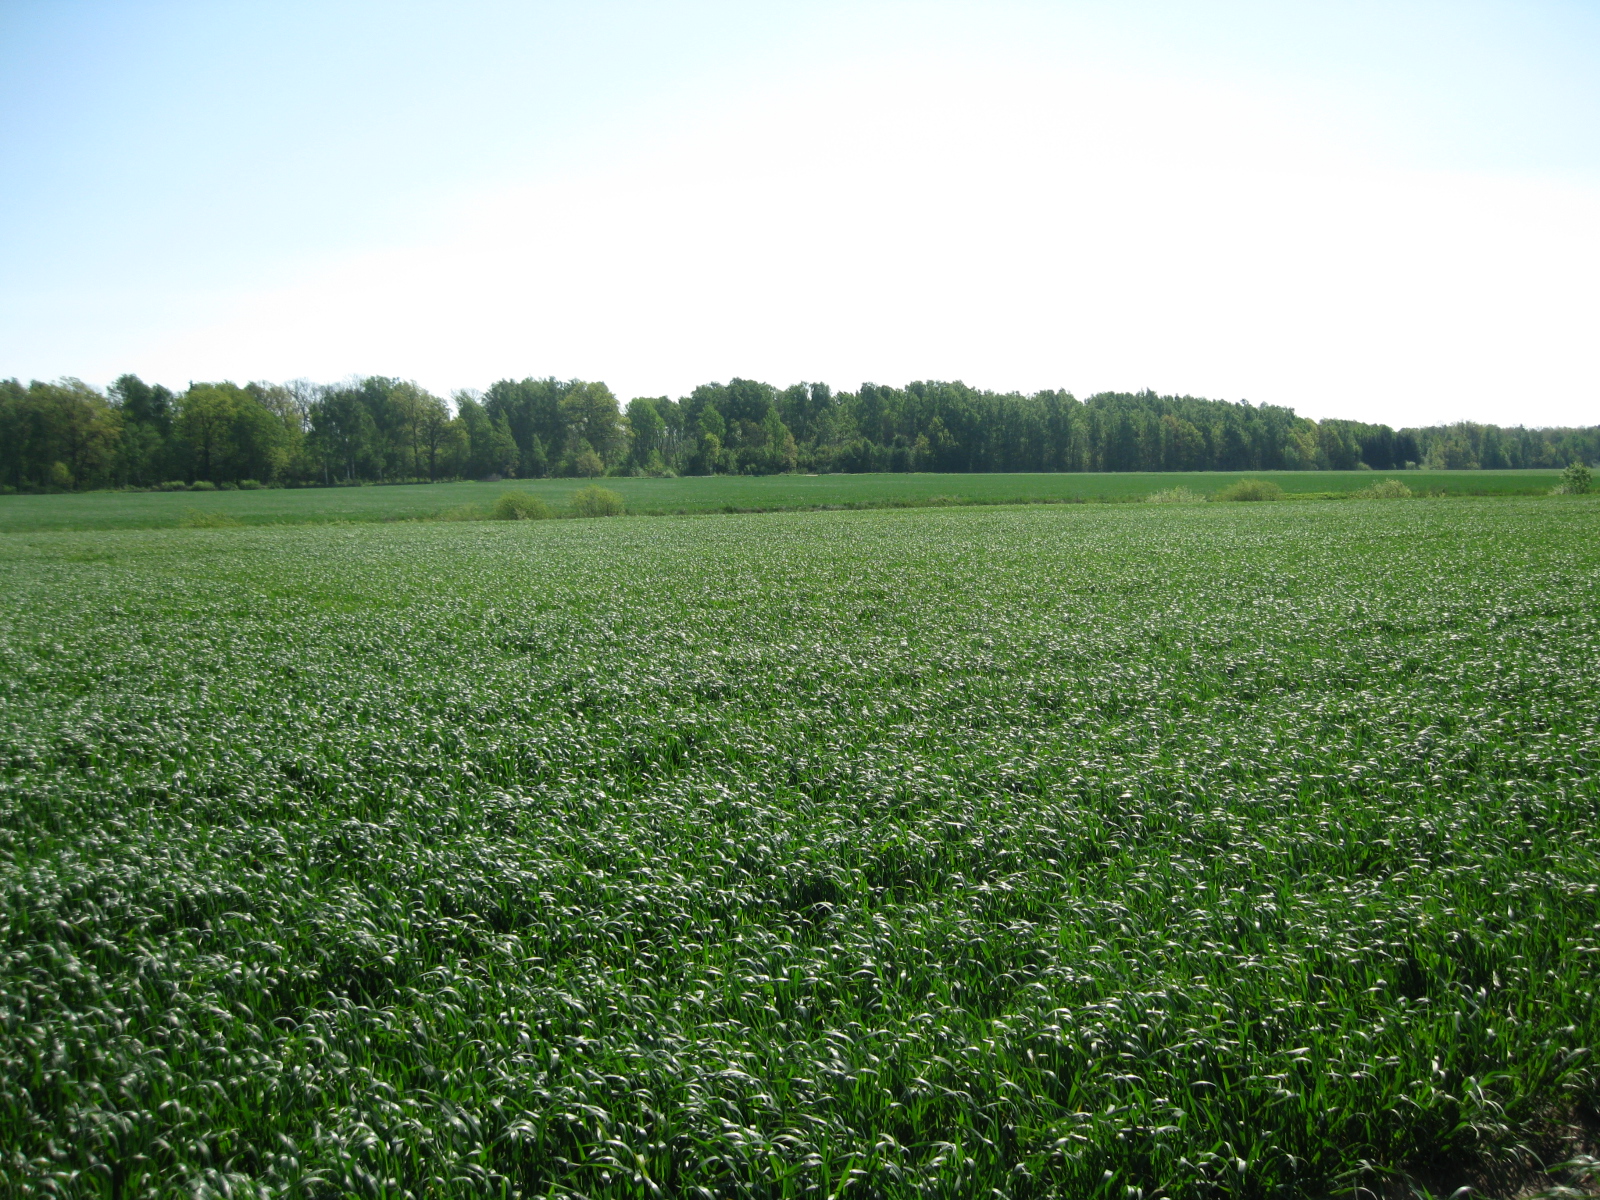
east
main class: Cropland
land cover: Common wheat
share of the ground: > 75 %
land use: Agriculture (excluding fallow land and kitchen gardens)
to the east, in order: Common wheat; Grass margins; Ditches and canals; Abandoned hedges; Grass margins; Common wheat
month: May
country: LT
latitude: 56.1066
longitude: 24.1923
